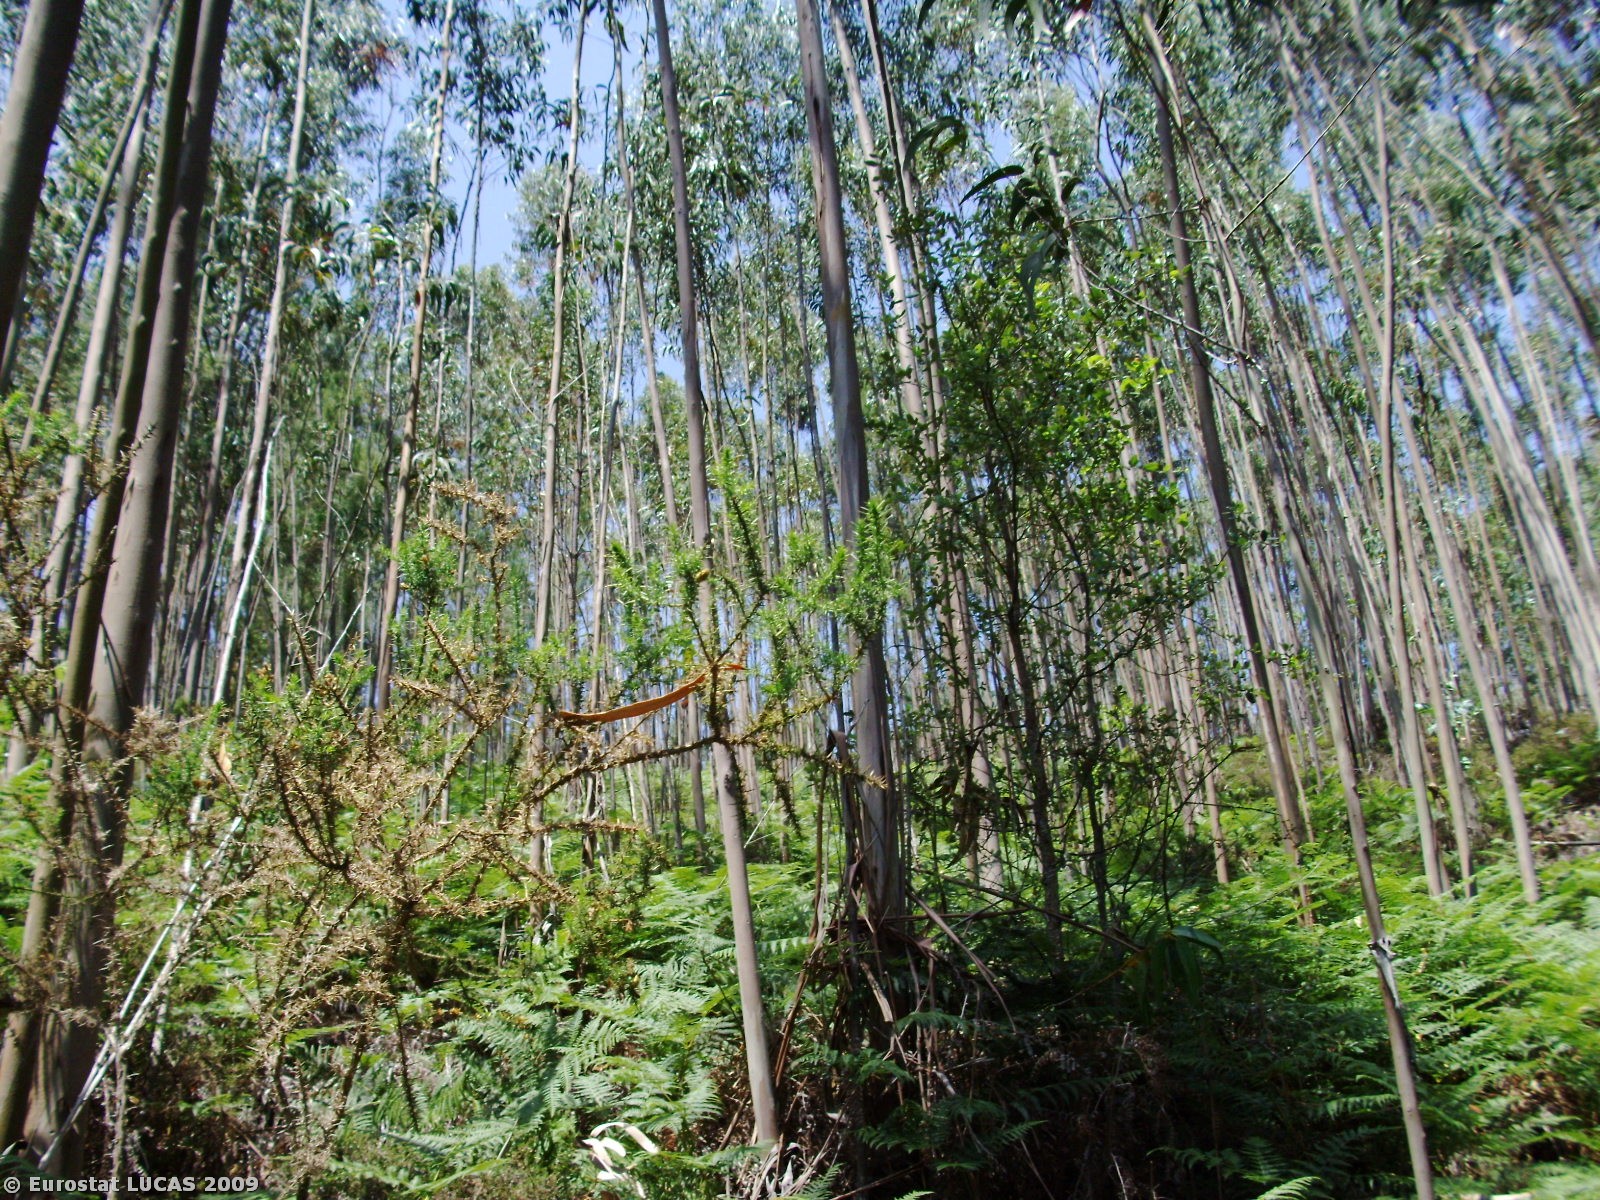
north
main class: Woodland
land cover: Broadleaved woodland
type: plantations and self-sown exotic forest
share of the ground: > 75 %
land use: Forestry
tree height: > 5 m
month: May
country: PT
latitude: 40.2684
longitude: -8.3931
